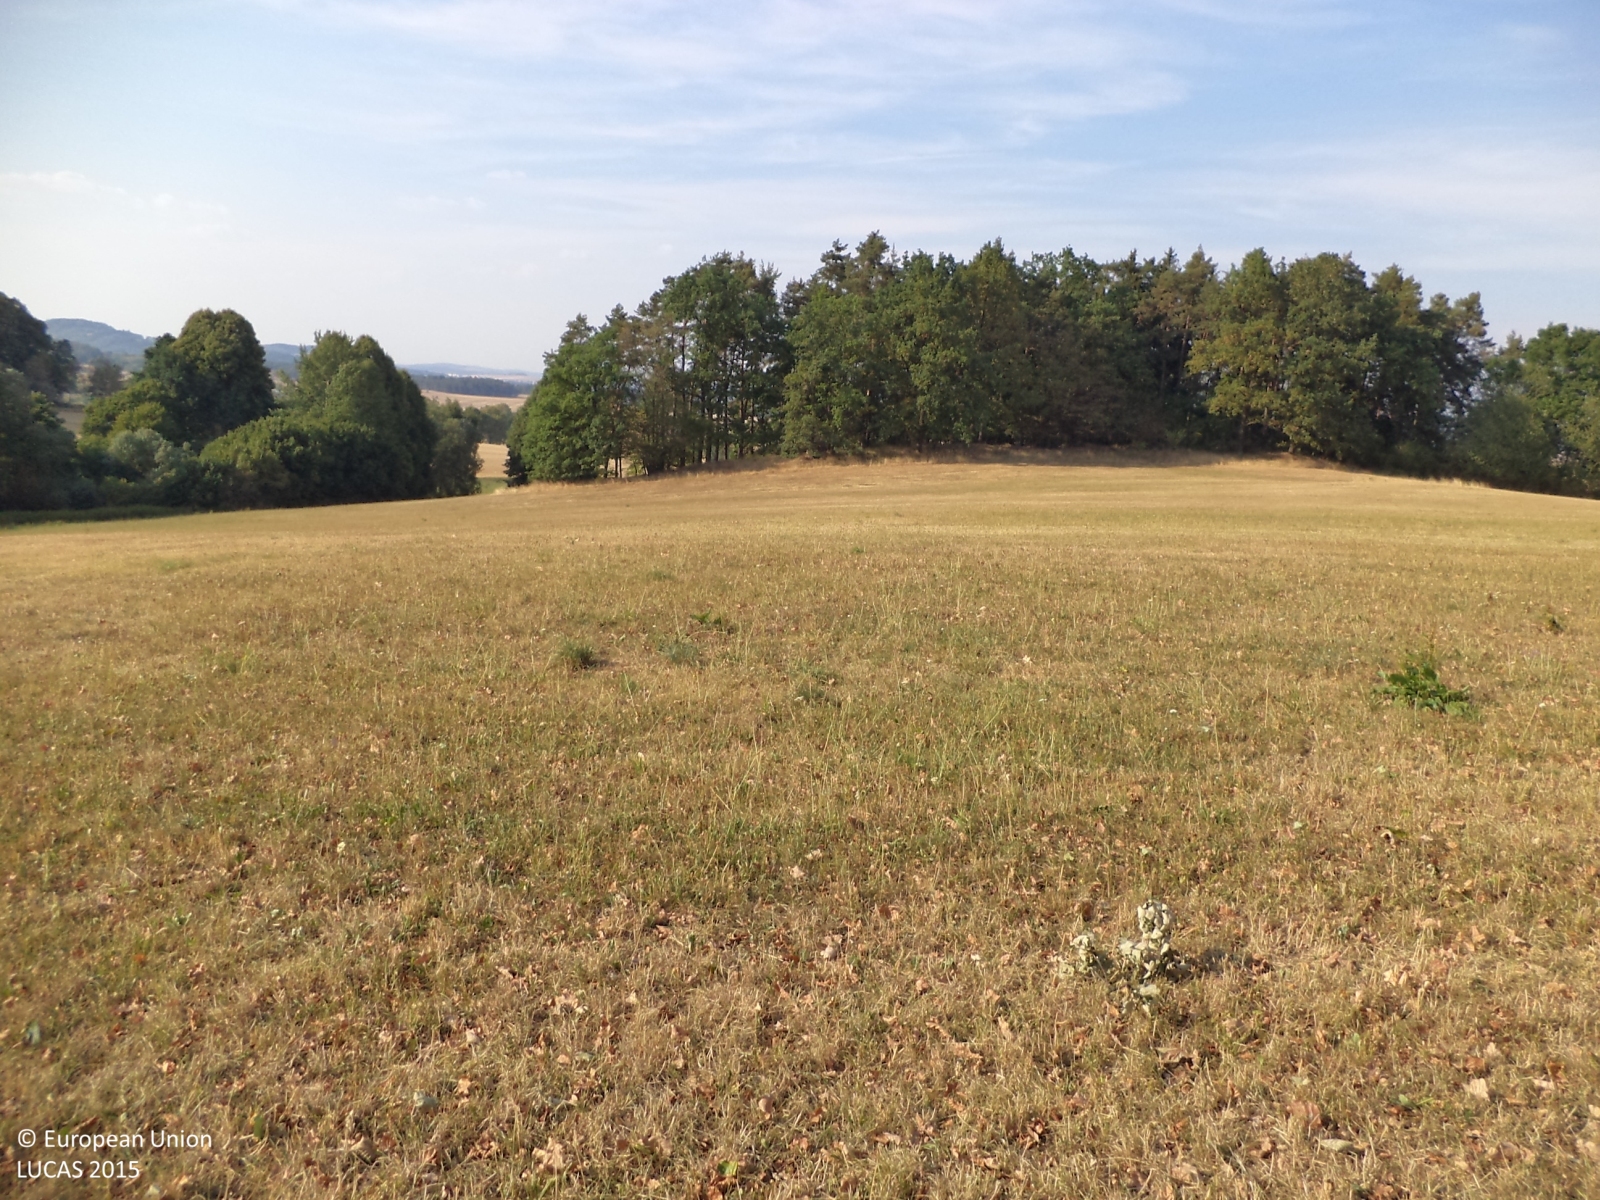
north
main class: Grassland
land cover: Grassland without tree/shrub cover
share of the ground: > 75 %
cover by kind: herbaceous plants 100 %
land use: Agriculture (excluding fallow land and kitchen gardens)
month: August
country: CZ
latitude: 49.5934
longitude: 14.4423
